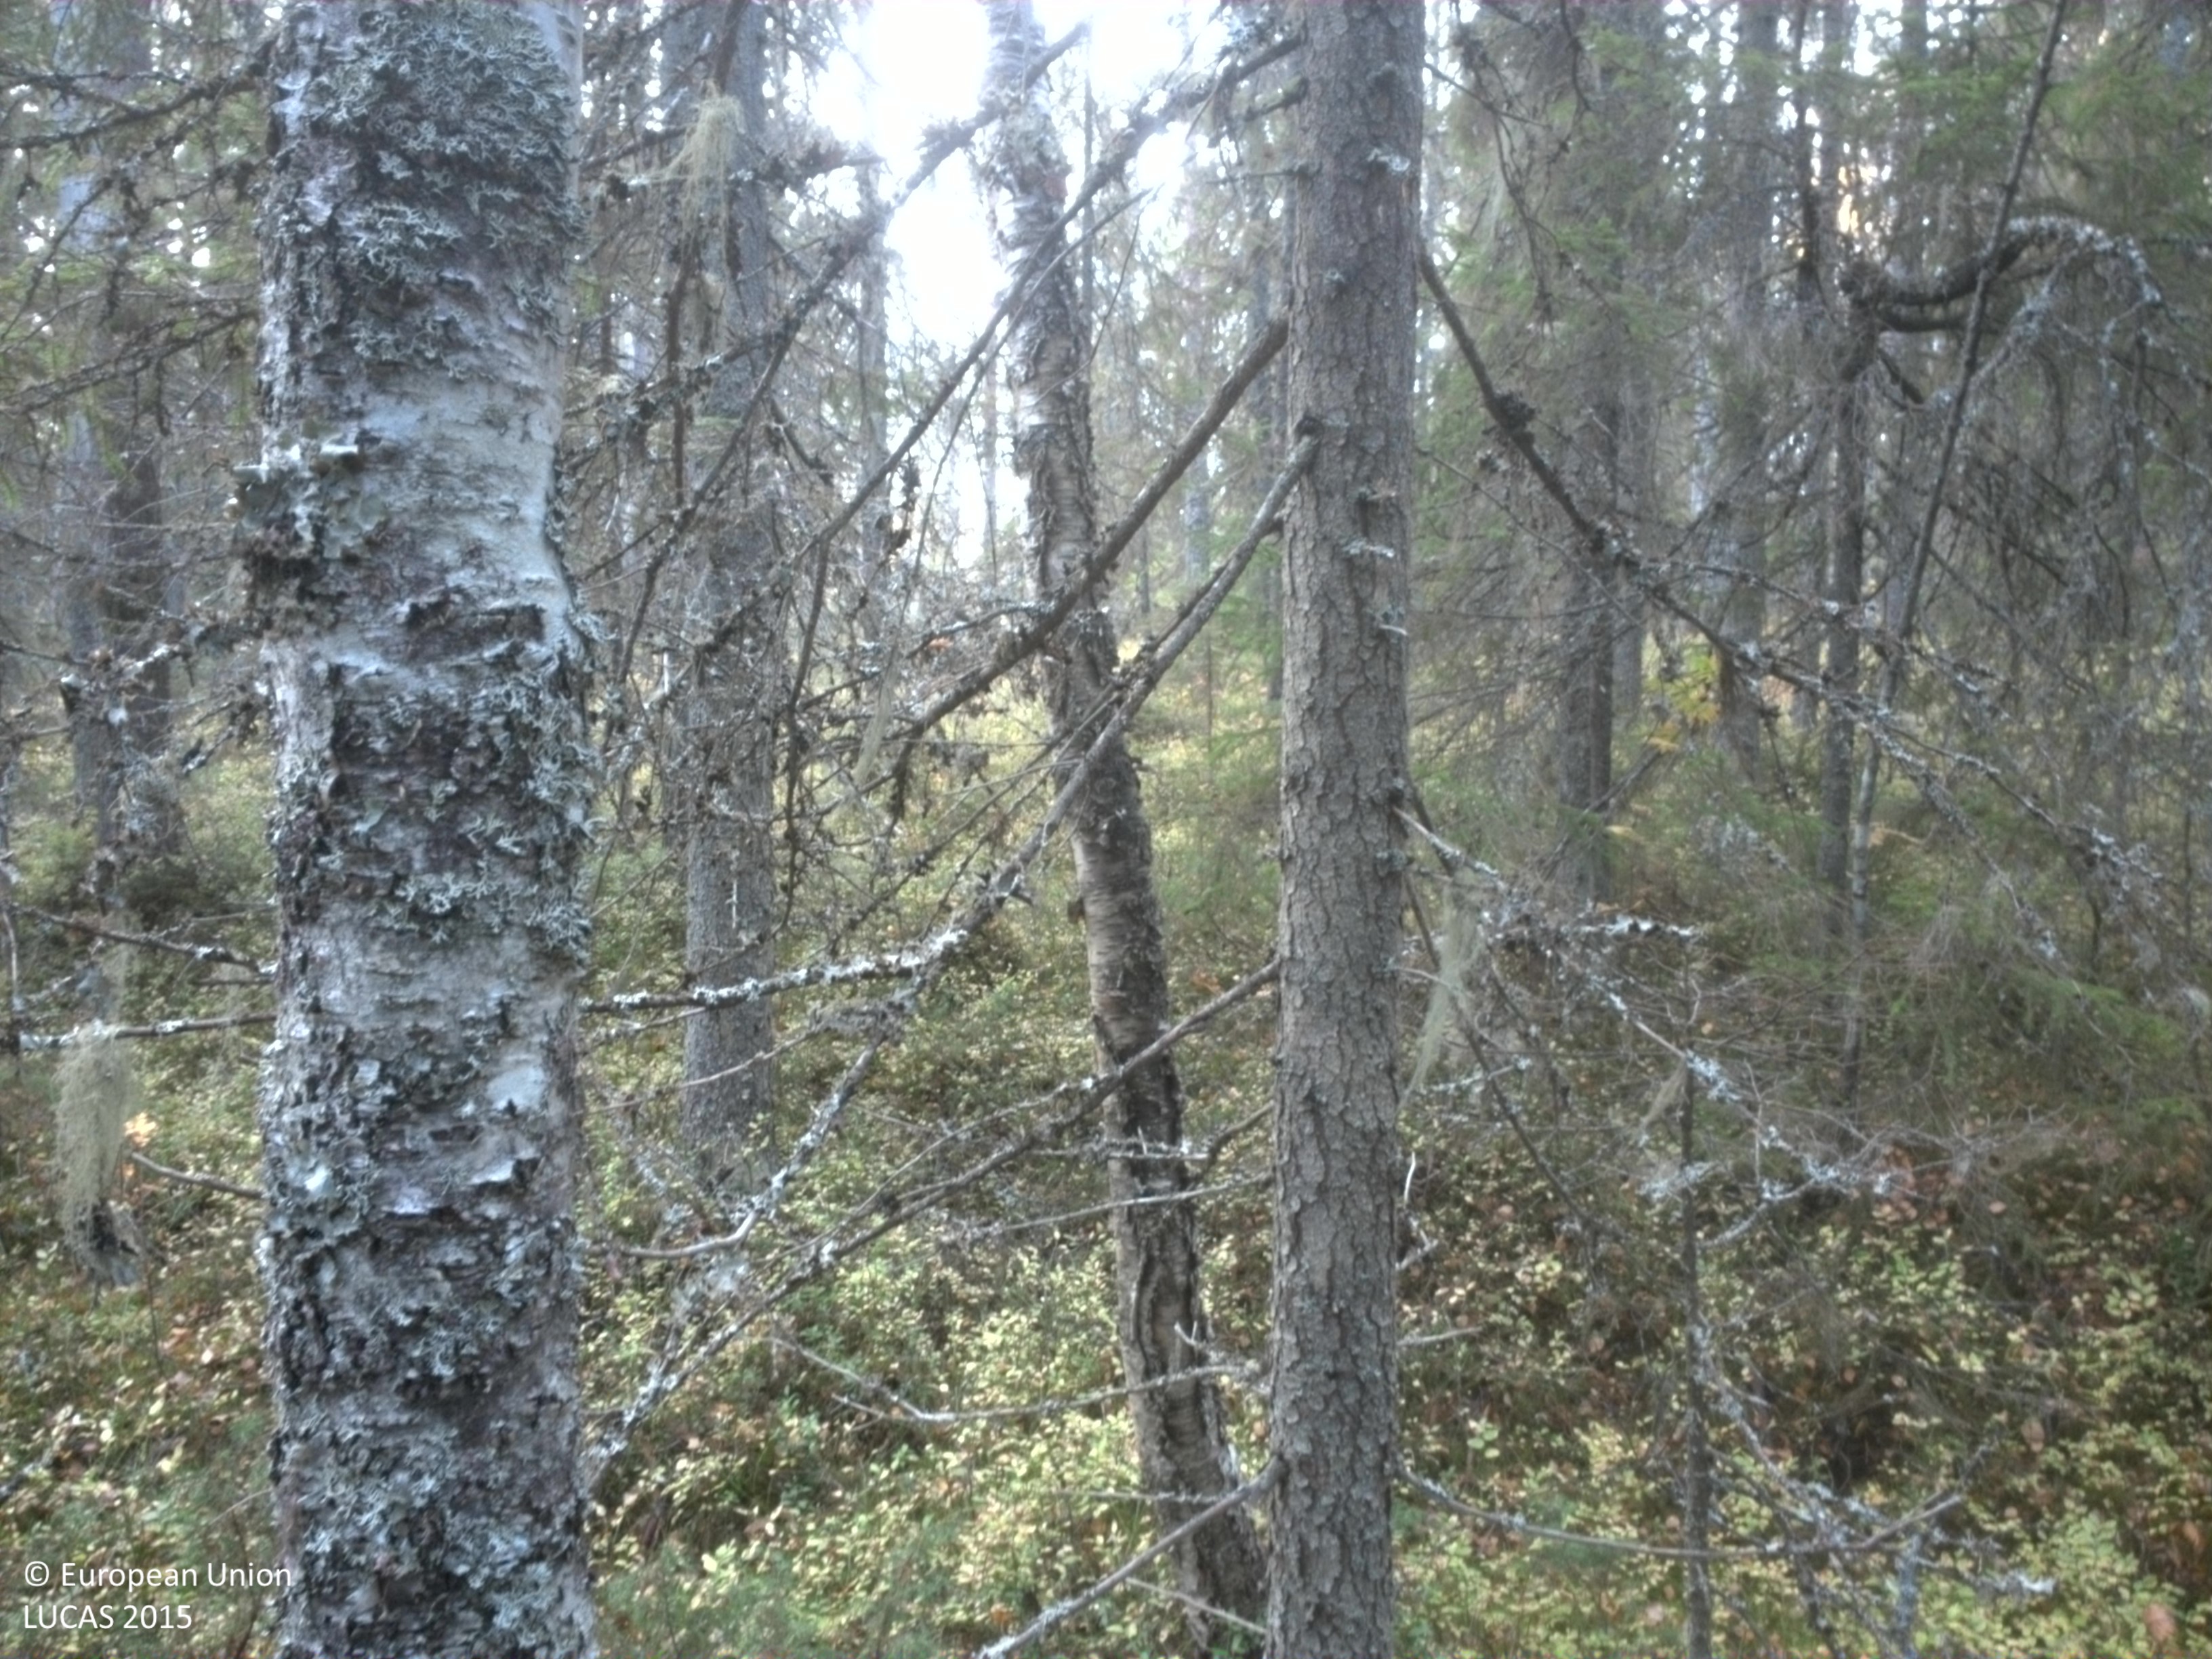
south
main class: Woodland
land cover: Spruce dominated coniferous woodland
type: boreal forest
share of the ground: 50 - 75 %
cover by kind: coniferous forest trees 60 %, shrubs 30 %, broadleaved forest trees 5 %, lichens and mosses 5 %
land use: Forestry
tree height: > 5 m
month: October
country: SE
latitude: 64.0433
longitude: 20.0329
